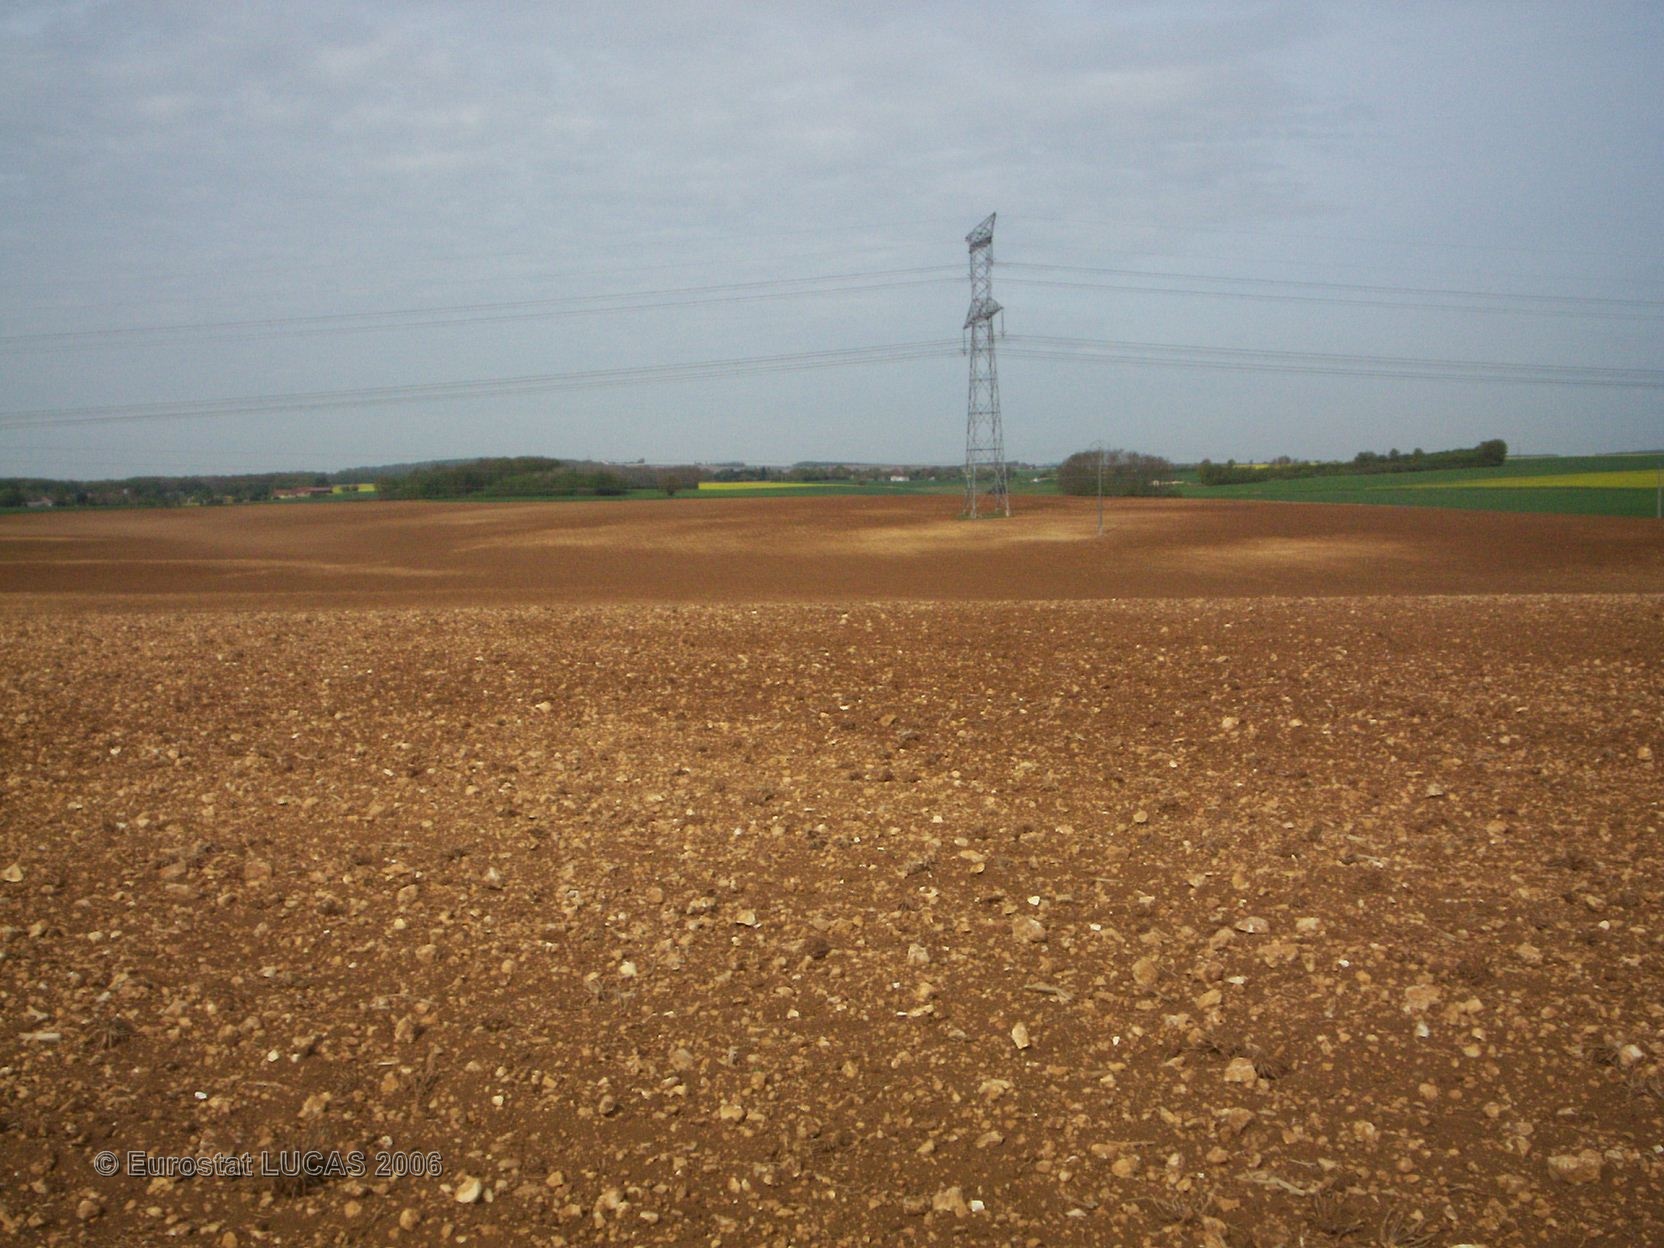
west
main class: Cropland
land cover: Sunflower
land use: Agriculture (excluding fallow land and kitchen gardens)
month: May
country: FR
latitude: 47.3160
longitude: 3.0231
